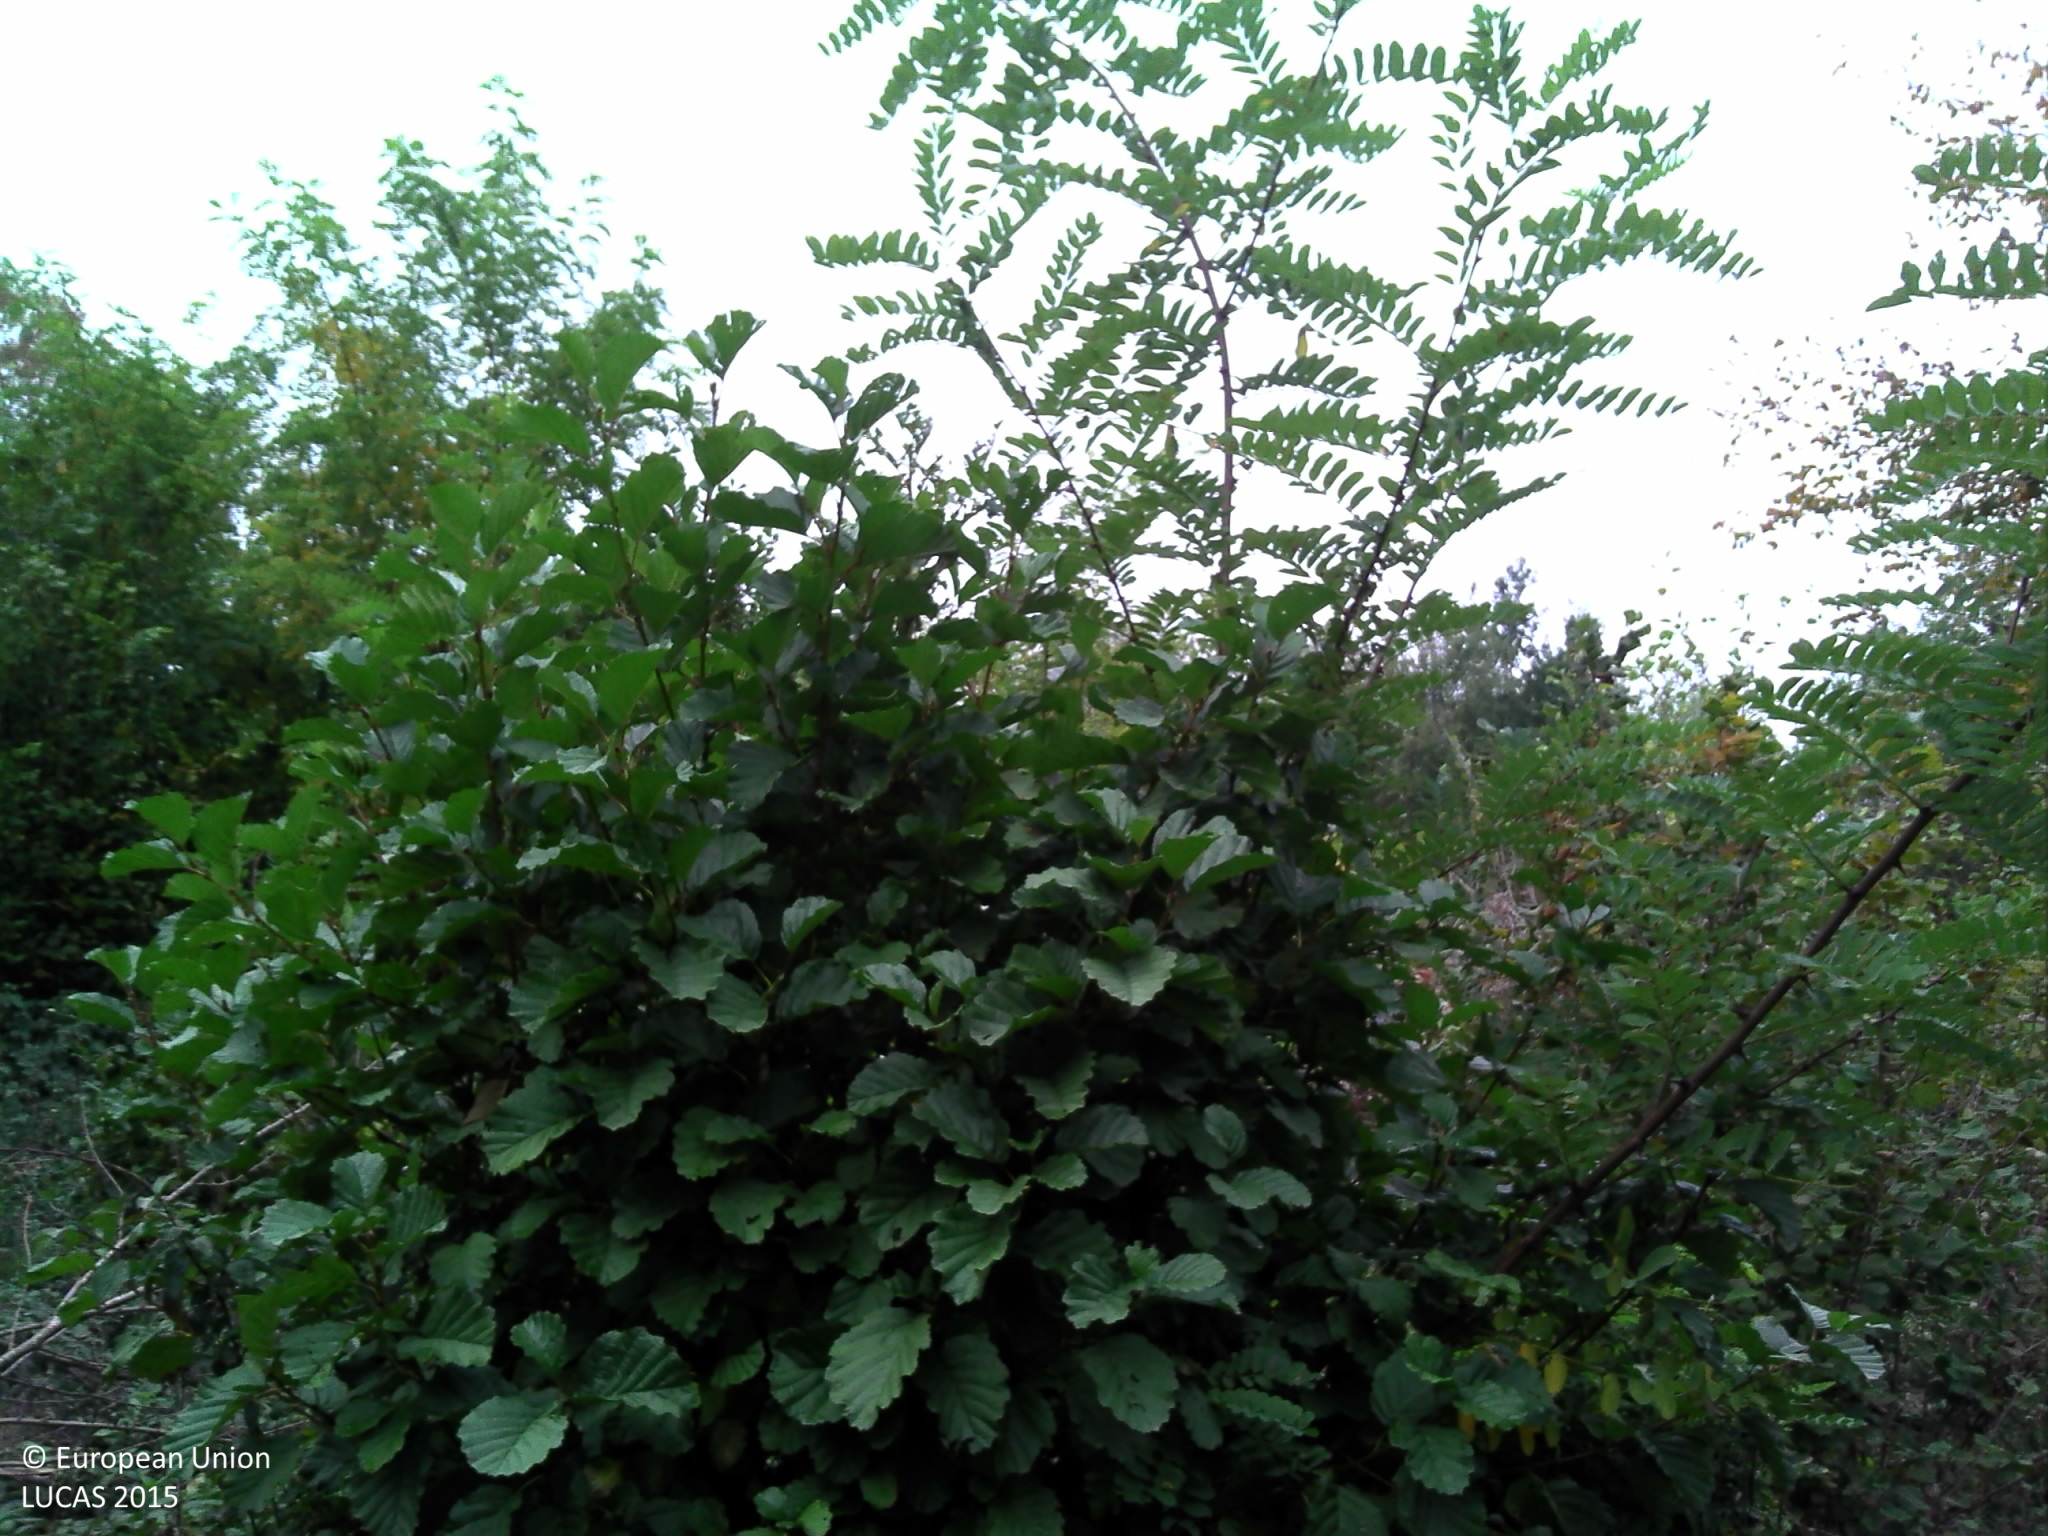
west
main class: Shrubland
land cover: Shrubland with sparse tree cover
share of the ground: > 75 %
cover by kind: shrubs 75 %, unconsolidated bare surface 15 %, broadleaved forest trees 5 %, herbaceous plants 5 %
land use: Forestry
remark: Clear cut
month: October
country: FR
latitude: 46.1964
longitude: 4.9619
